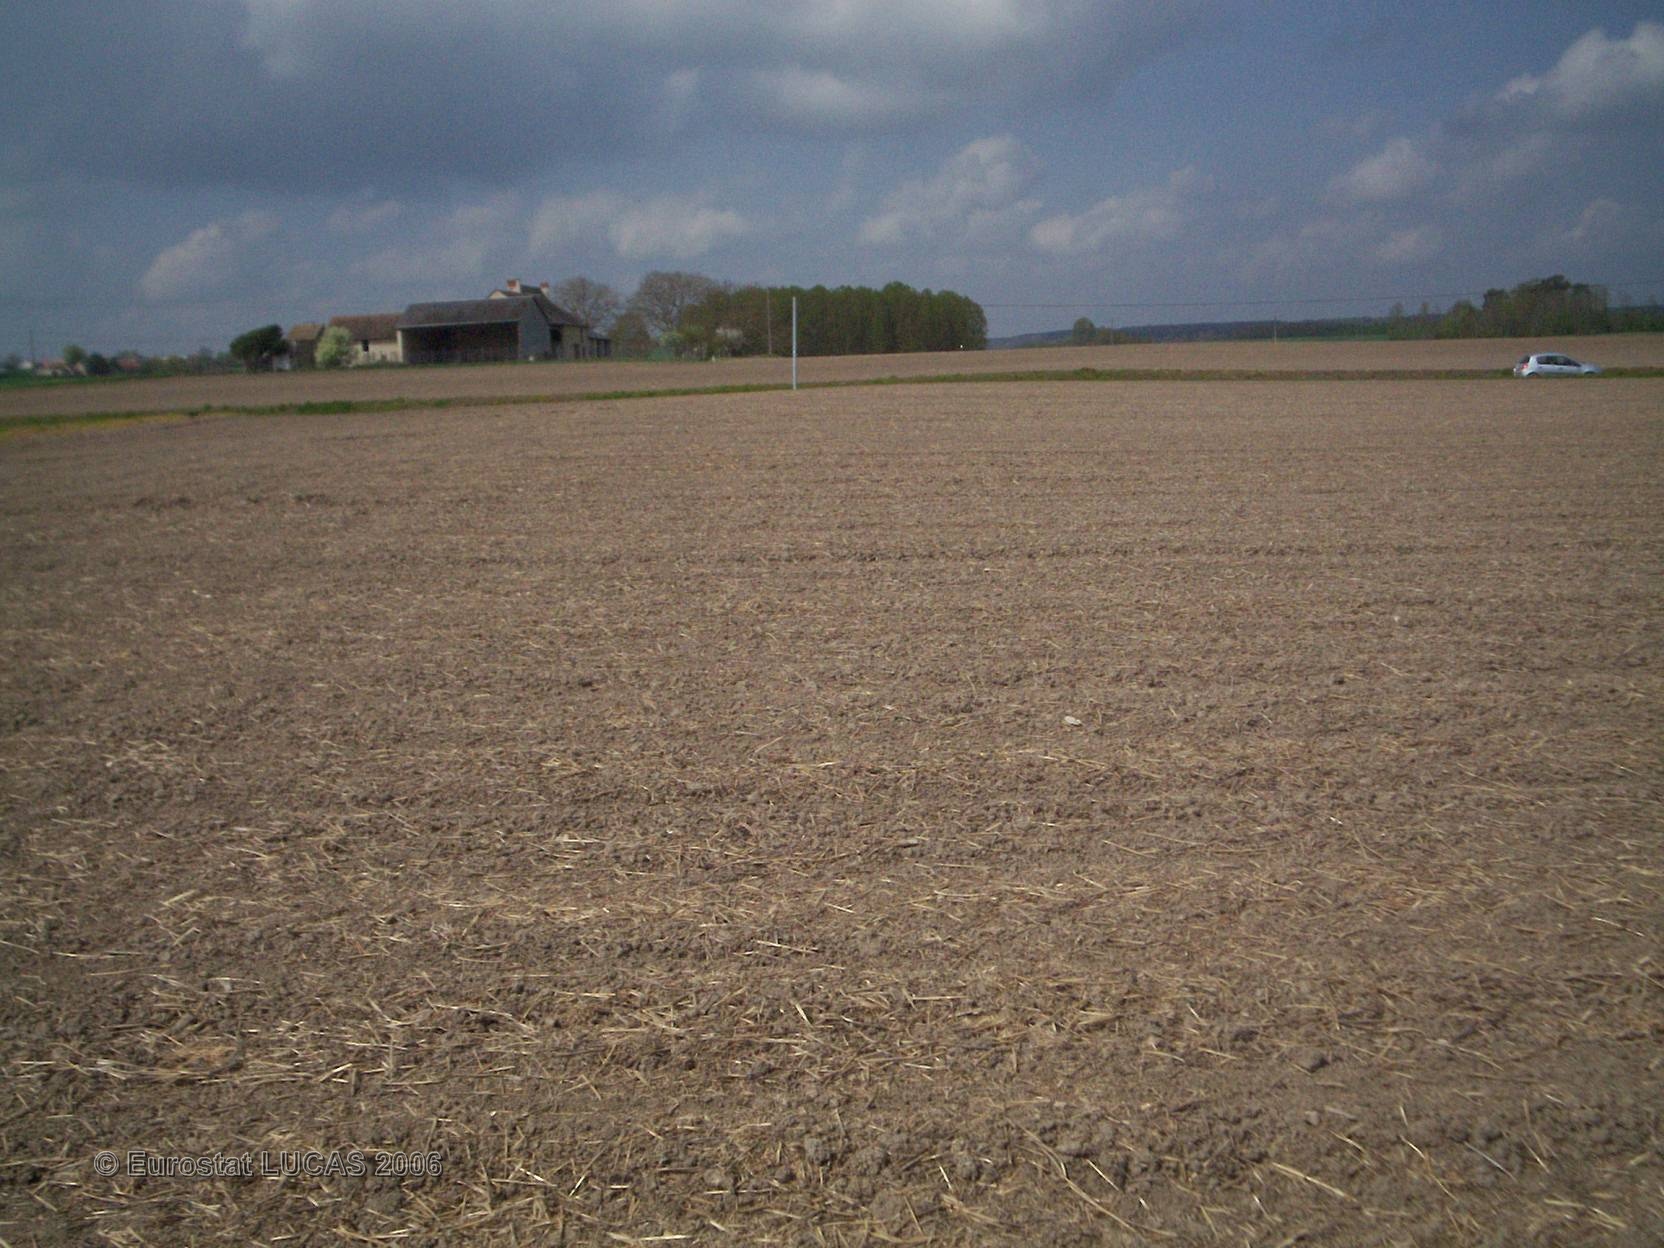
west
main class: Cropland
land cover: Maize
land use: Agriculture (excluding fallow land and kitchen gardens)
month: June
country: FR
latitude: 46.8542
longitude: 0.5250
